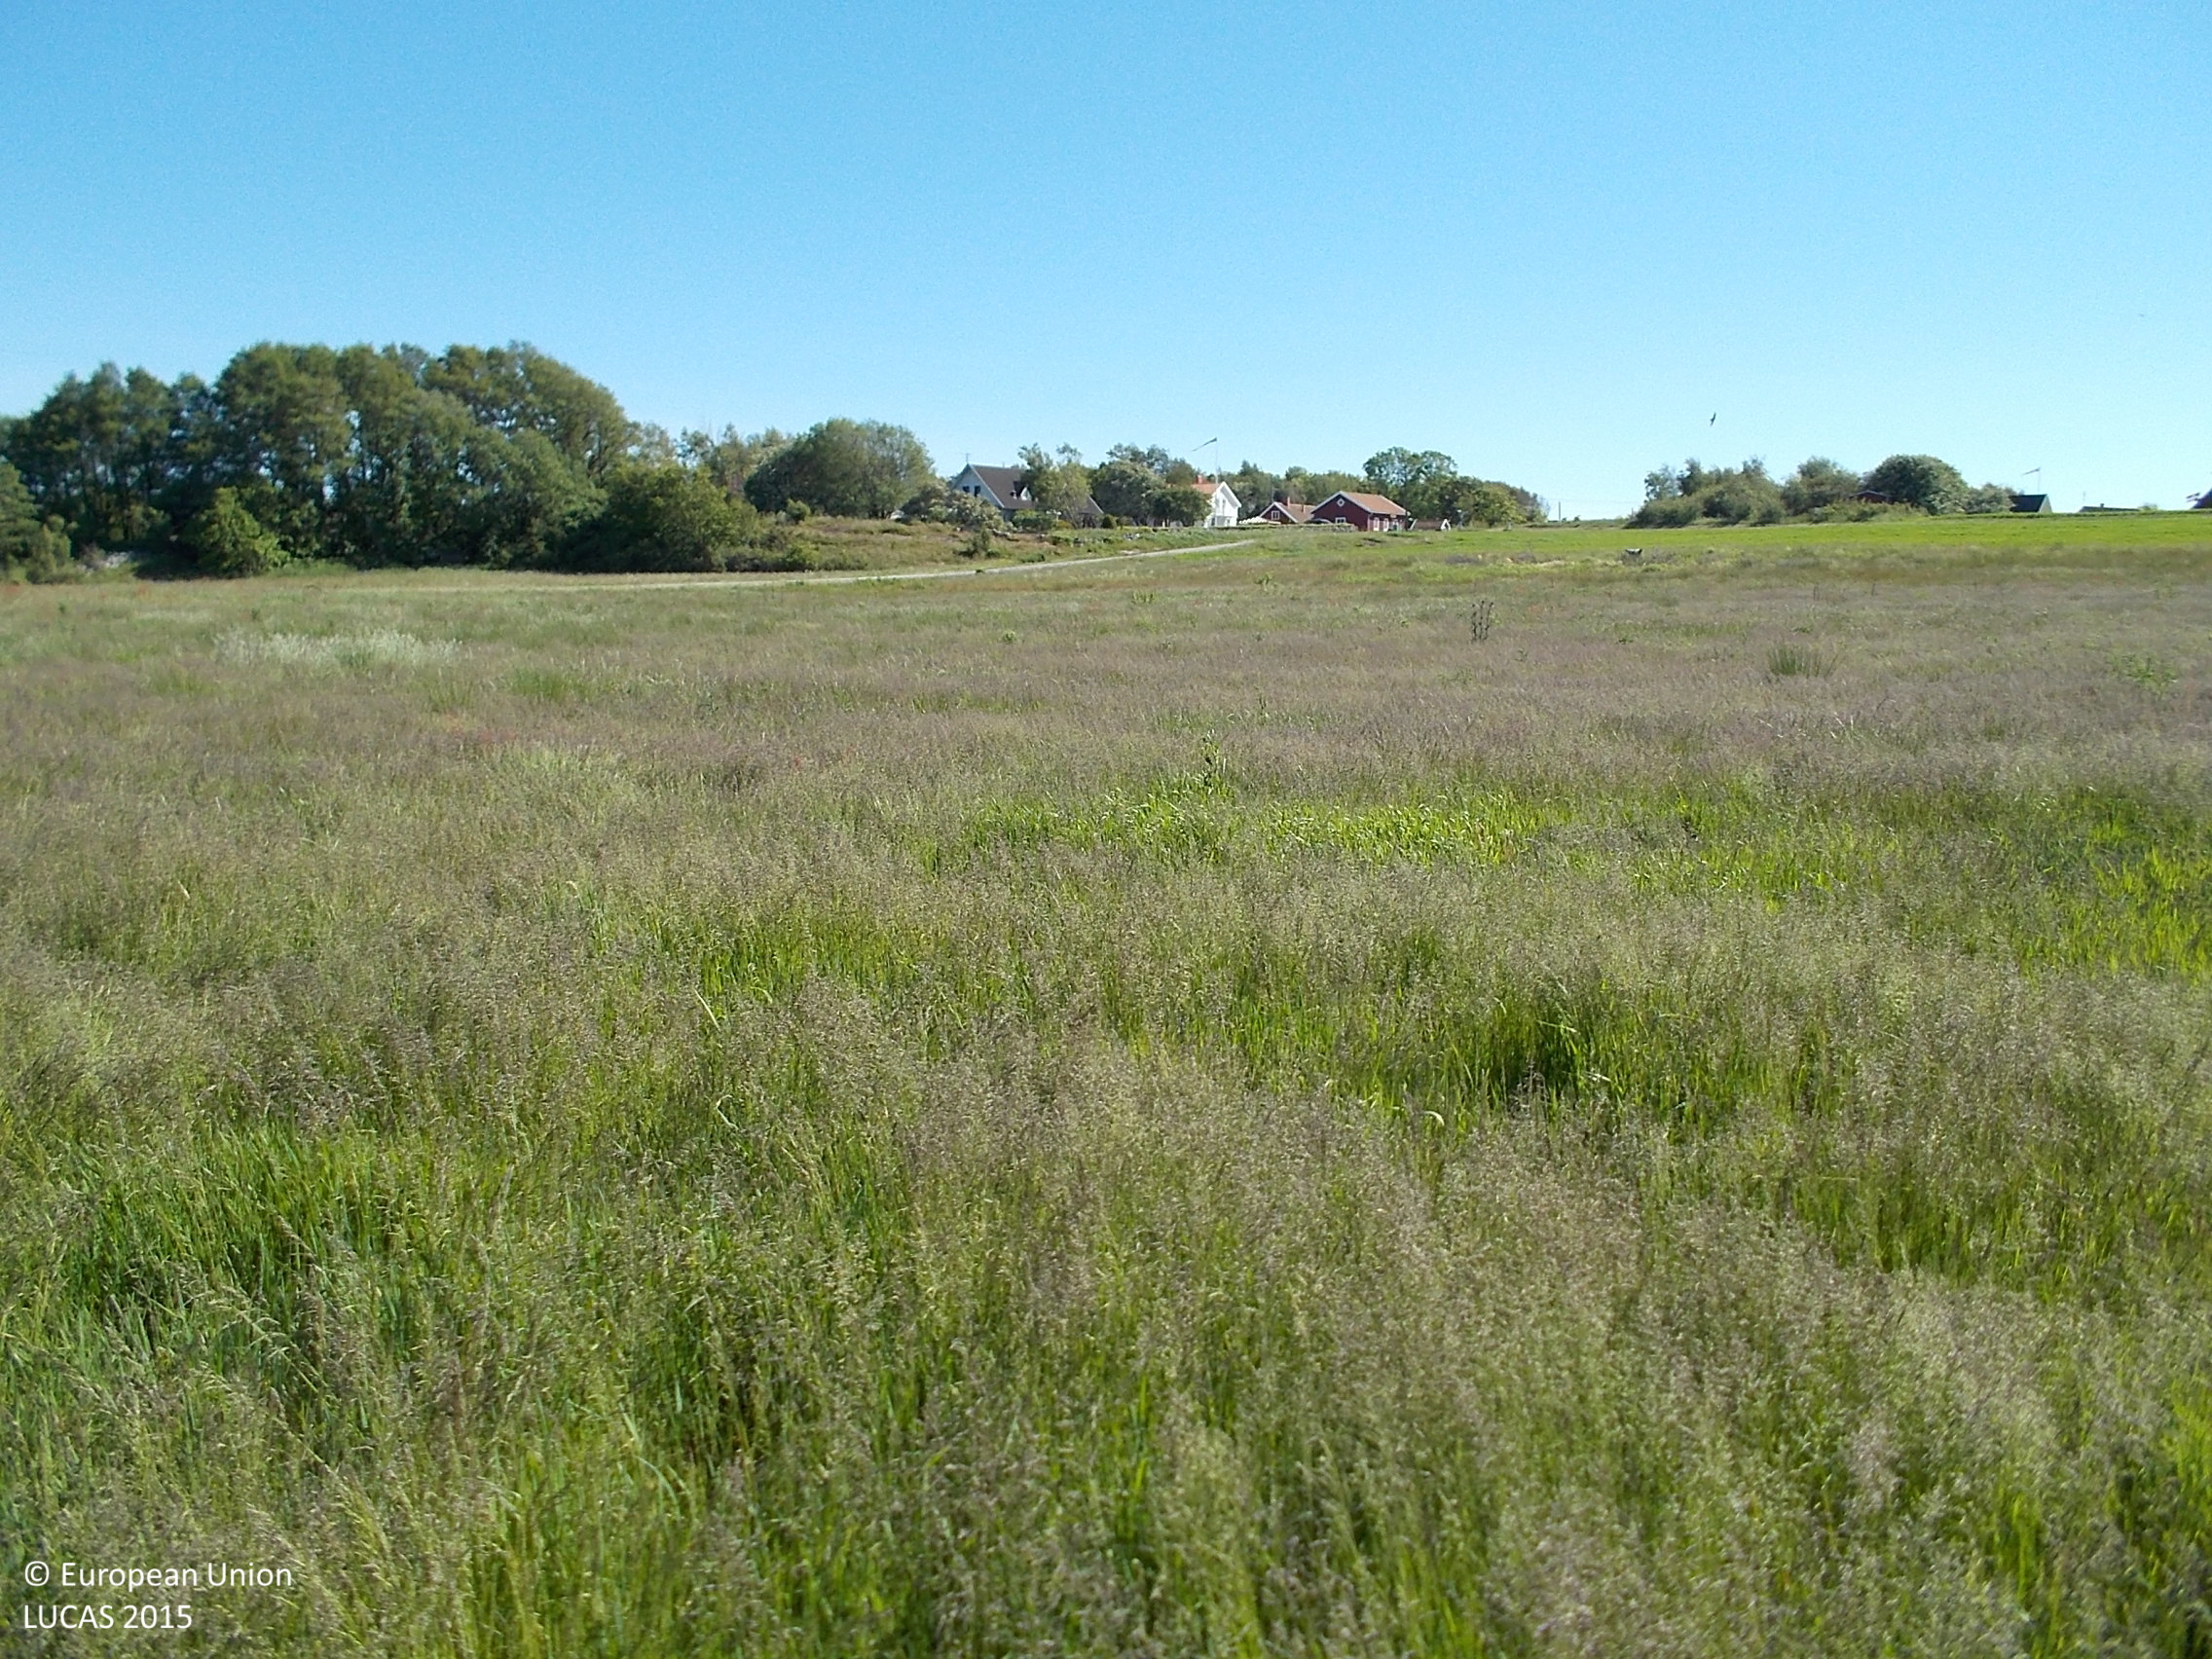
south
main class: Grassland
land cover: Grassland without tree/shrub cover
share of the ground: > 75 %
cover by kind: herbaceous plants 100 %
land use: Agriculture (excluding fallow land and kitchen gardens)
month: June
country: SE
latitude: 57.2311
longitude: 12.1339
